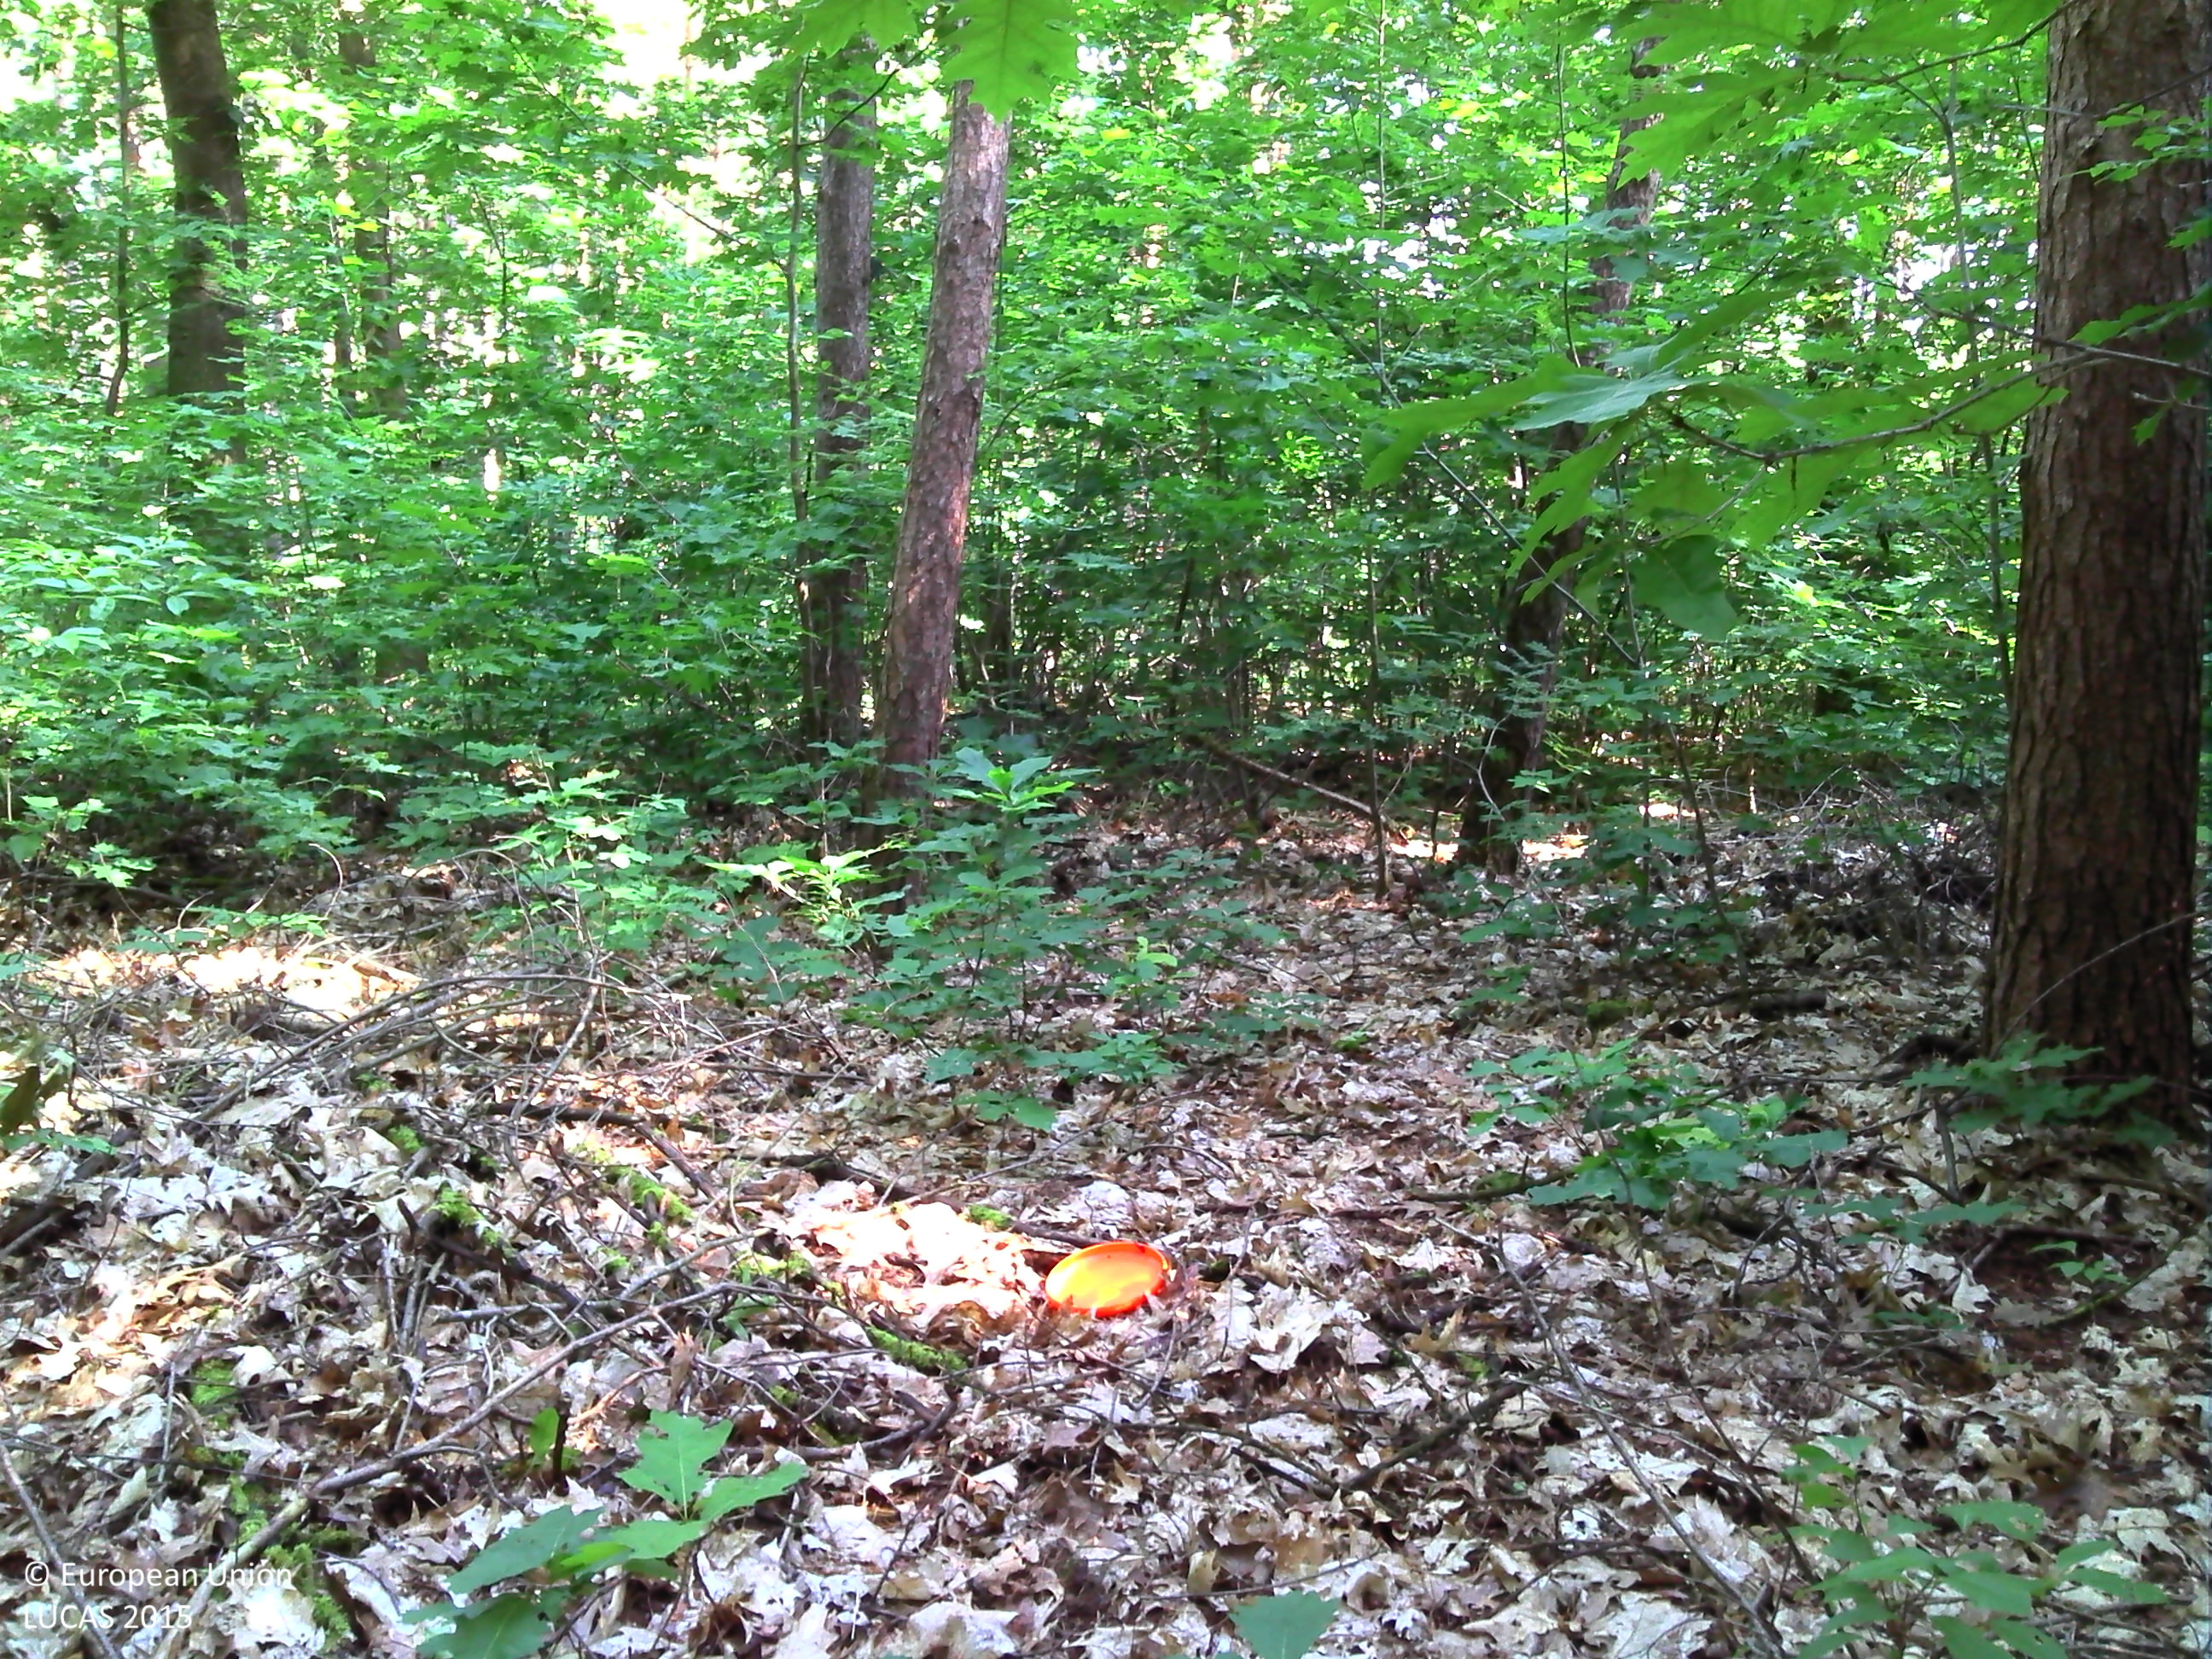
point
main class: Woodland
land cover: Pine dominated mixed woodland
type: exotic forest
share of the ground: > 75 %
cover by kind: coniferous forest trees 50 %, broadleaved forest trees 40 %, herbaceous plants 10 %
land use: Forestry
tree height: > 5 m
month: June
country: BE
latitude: 50.9087
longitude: 5.5753
